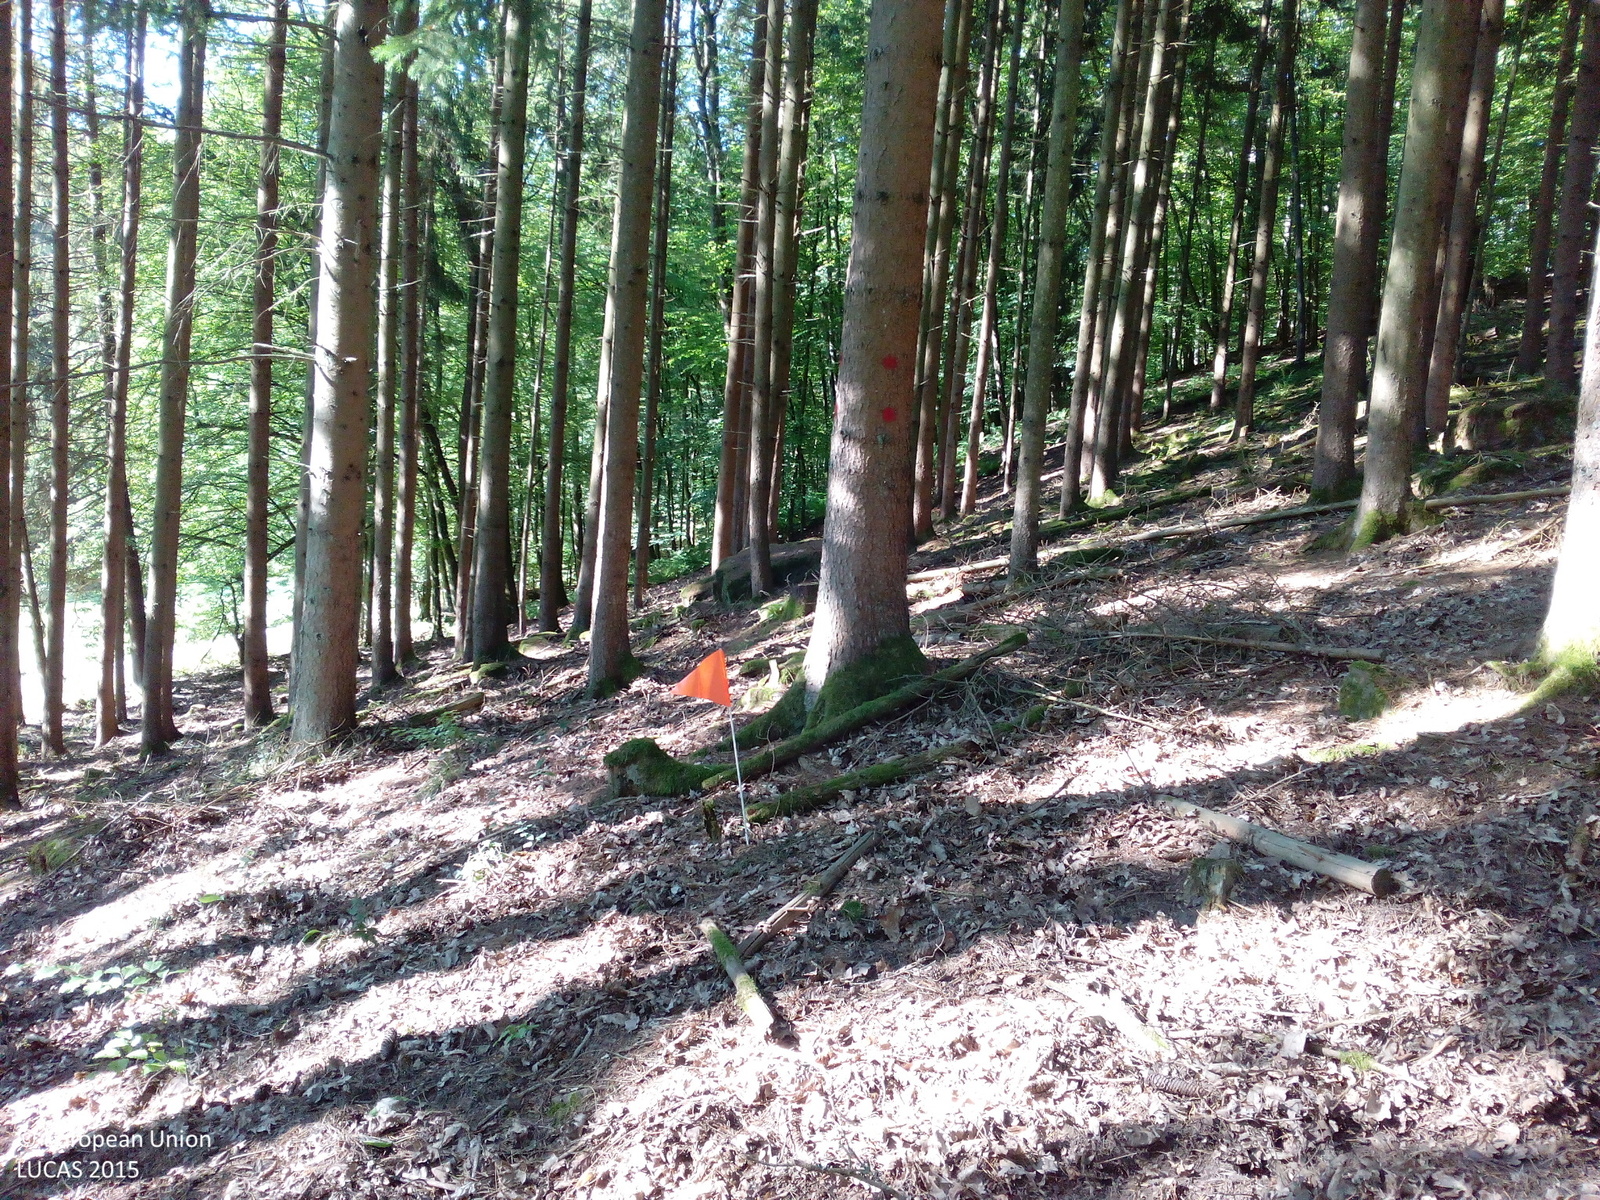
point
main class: Woodland
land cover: Spruce dominated coniferous woodland
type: hemiboreal forest and nemoral coniferous forest and mixed broadleaved-coniferous forest
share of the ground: > 75 %
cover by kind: coniferous forest trees 90 %, unconsolidated bare surface 10 %
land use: Forestry
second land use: Amenities, museums, leisure
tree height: > 5 m
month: September
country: DE
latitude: 49.9137
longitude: 9.5684
